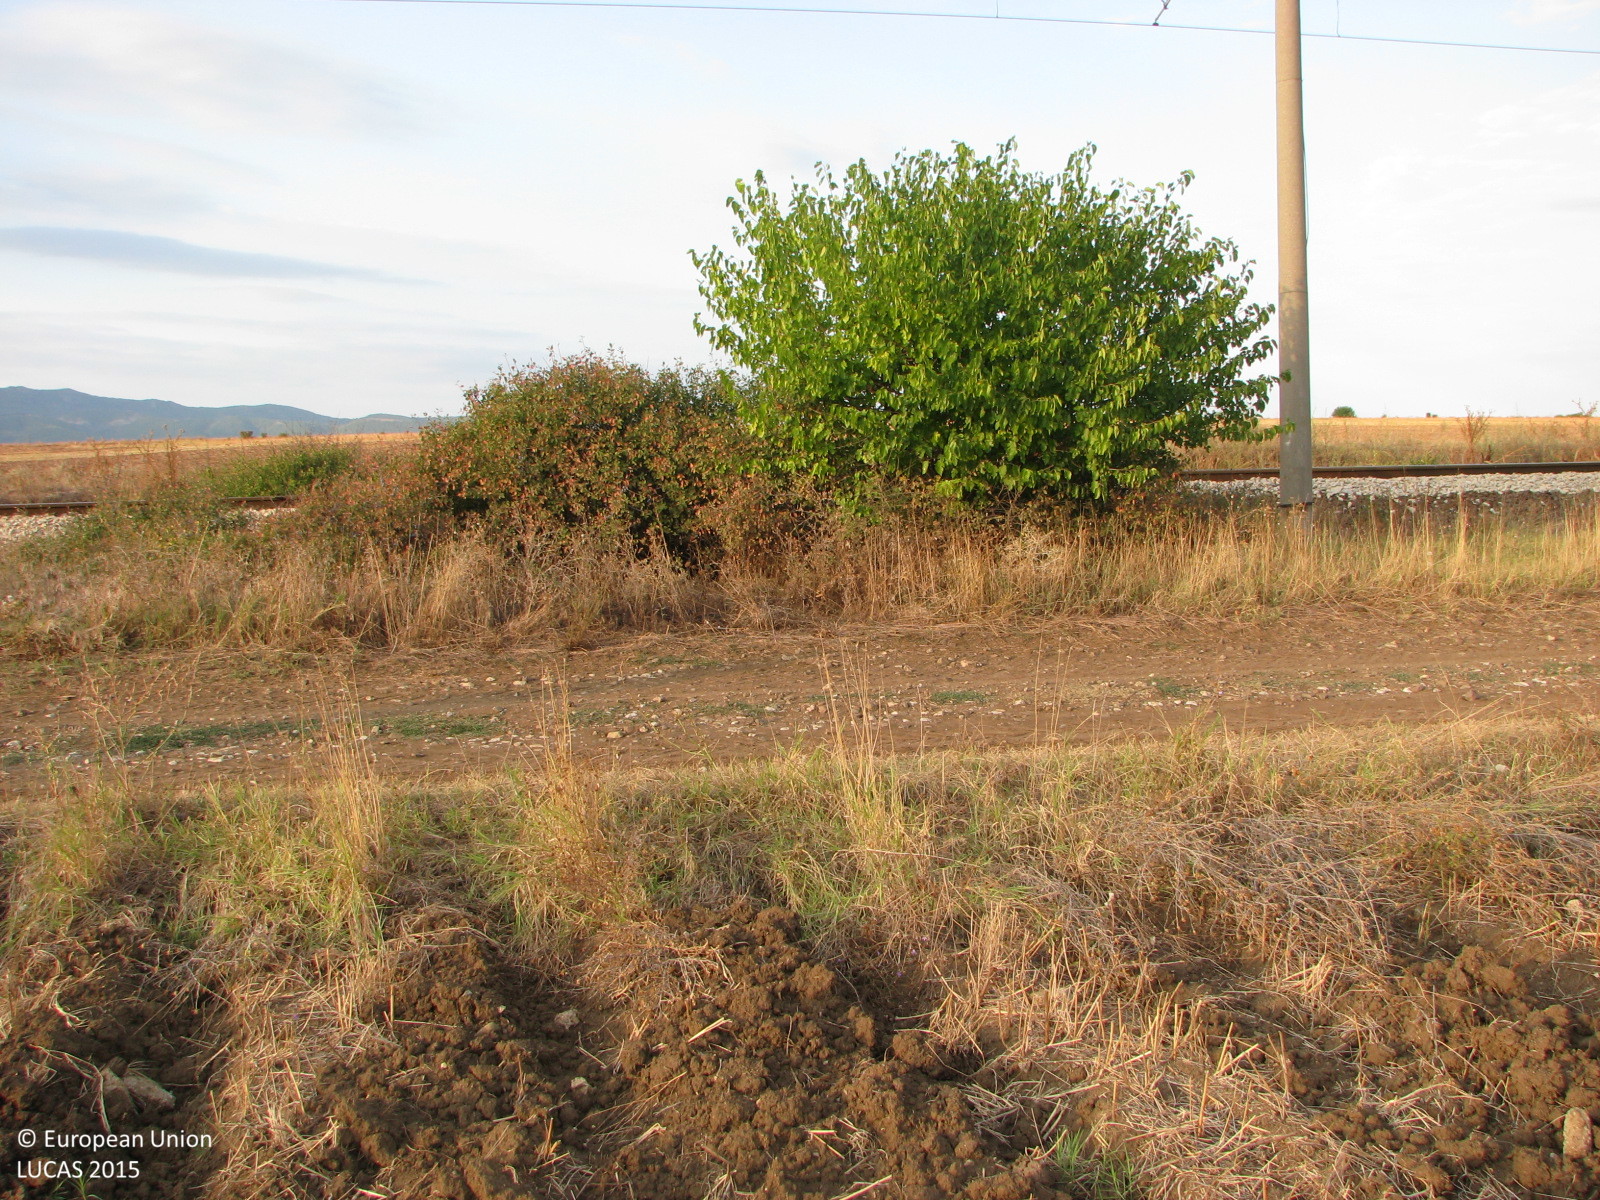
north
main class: Cropland
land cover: Common wheat
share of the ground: < 10 %
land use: Agriculture (excluding fallow land and kitchen gardens)
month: September
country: BG
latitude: 42.5902
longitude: 26.5333
